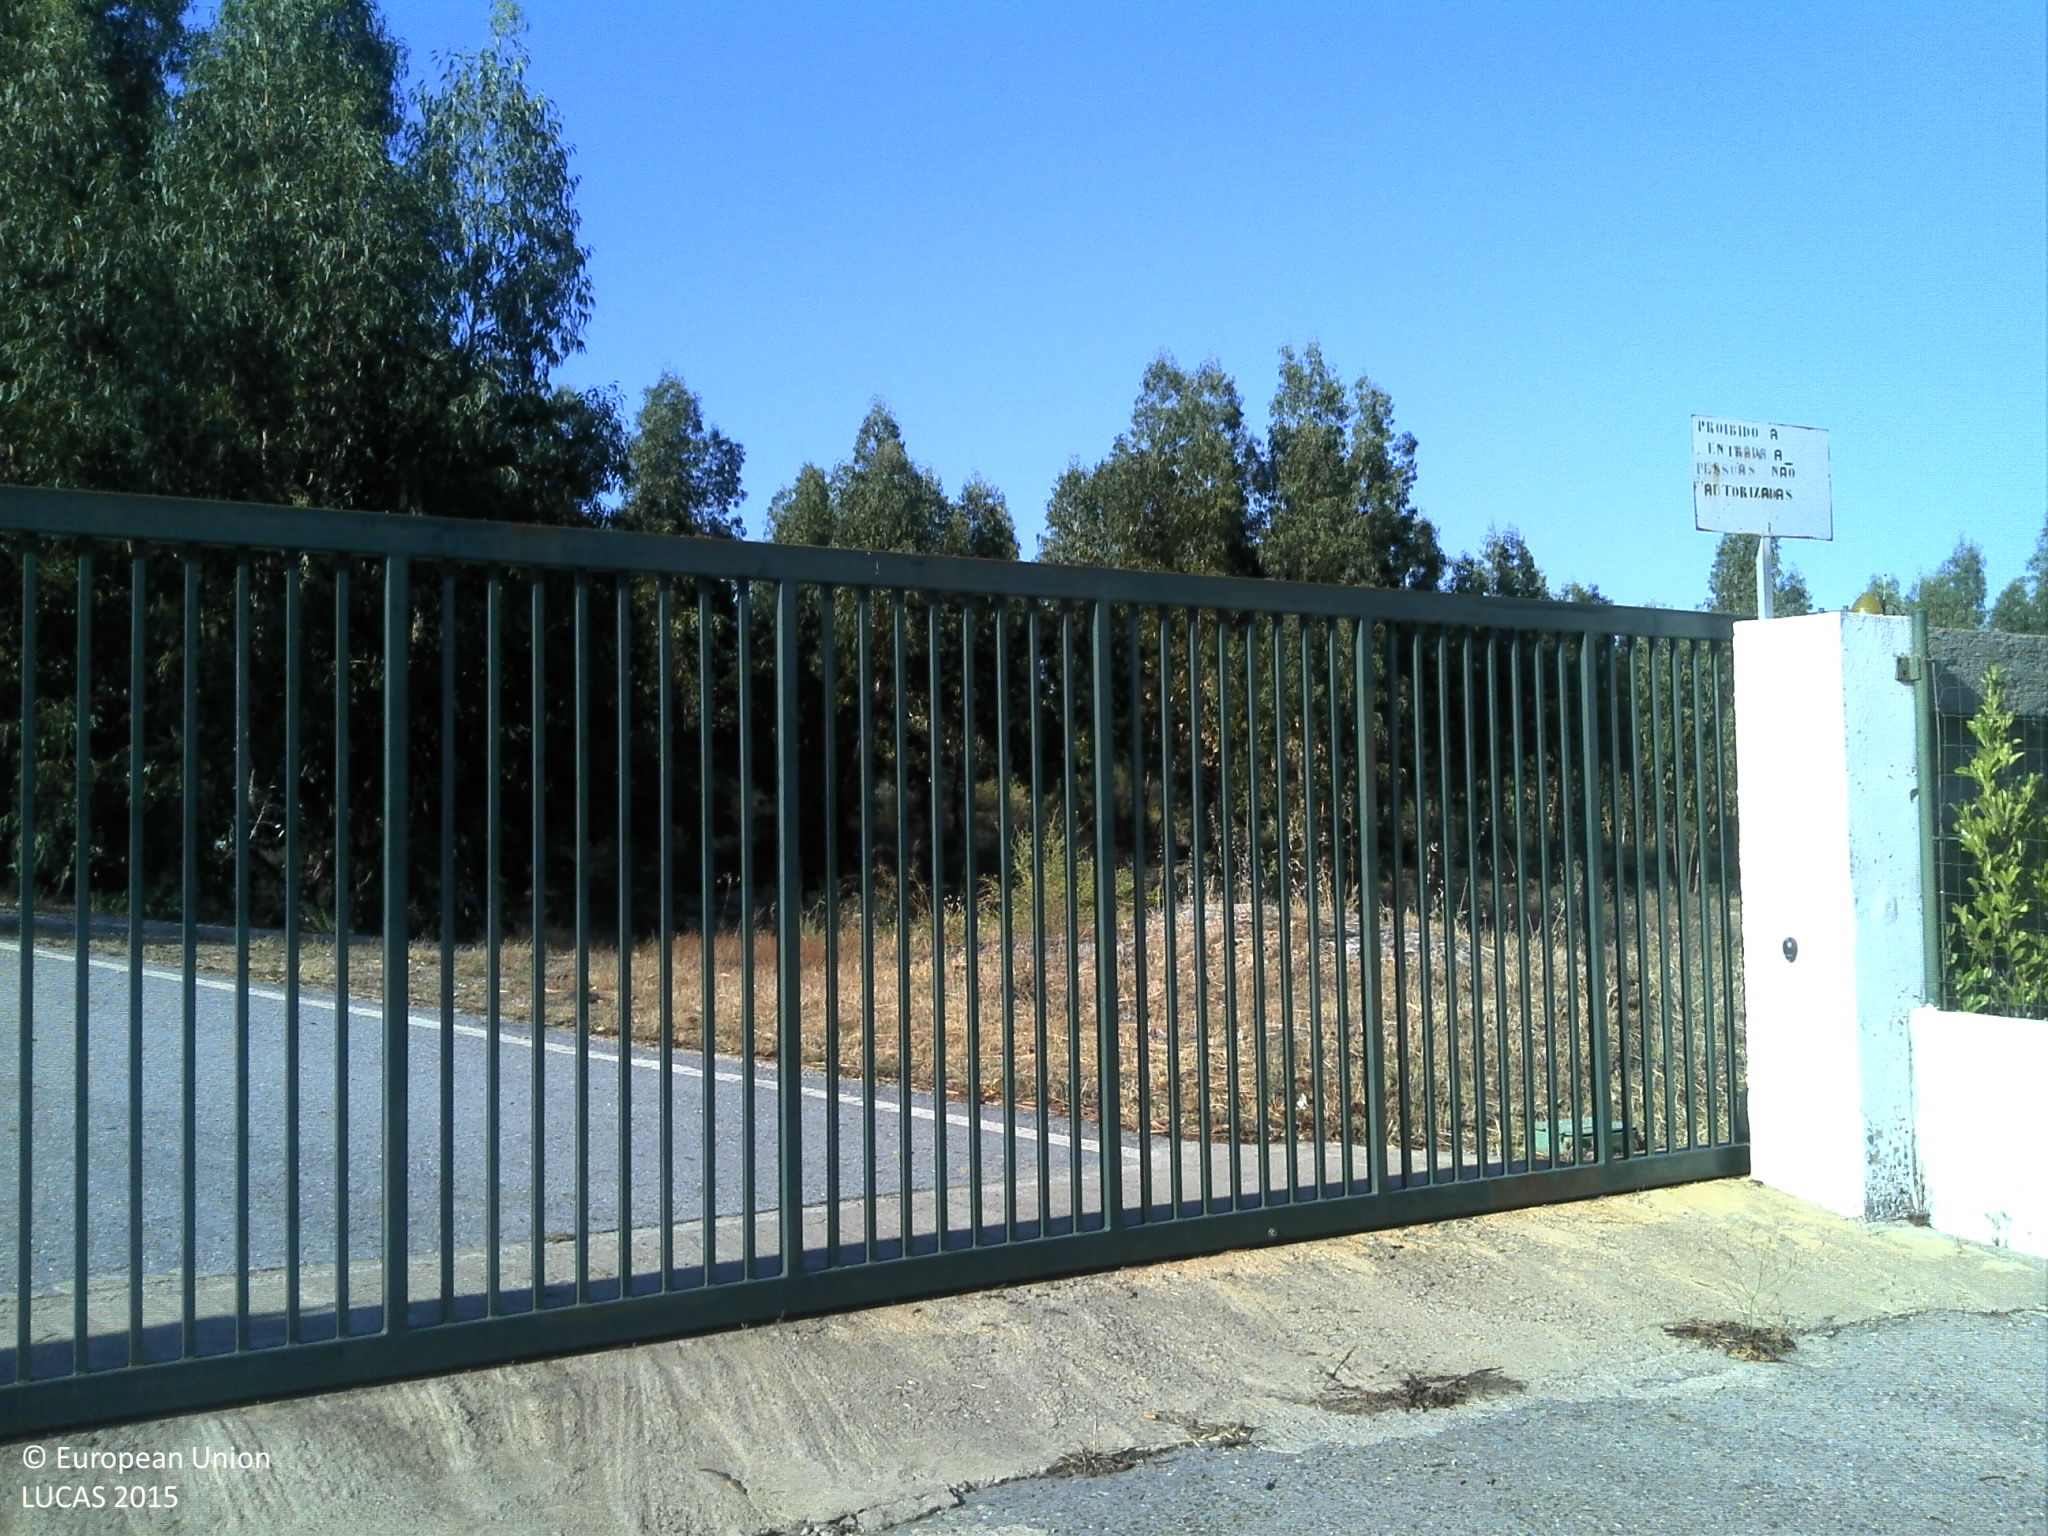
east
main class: Woodland
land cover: Broadleaved woodland
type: broadleaved evergreen forest
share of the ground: 25 - 50 %
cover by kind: broadleaved forest trees 40 %, unconsolidated bare surface 40 %, herbaceous plants 20 %
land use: Forestry
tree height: > 5 m
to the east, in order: Broadleaved woodland; Tracks; Broadleaved woodland; Grassland without tree/shrub cover; Tracks; Grassland without tree/shrub cover; Broadleaved woodland
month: June
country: PT
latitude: 39.9519
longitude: -7.4111
